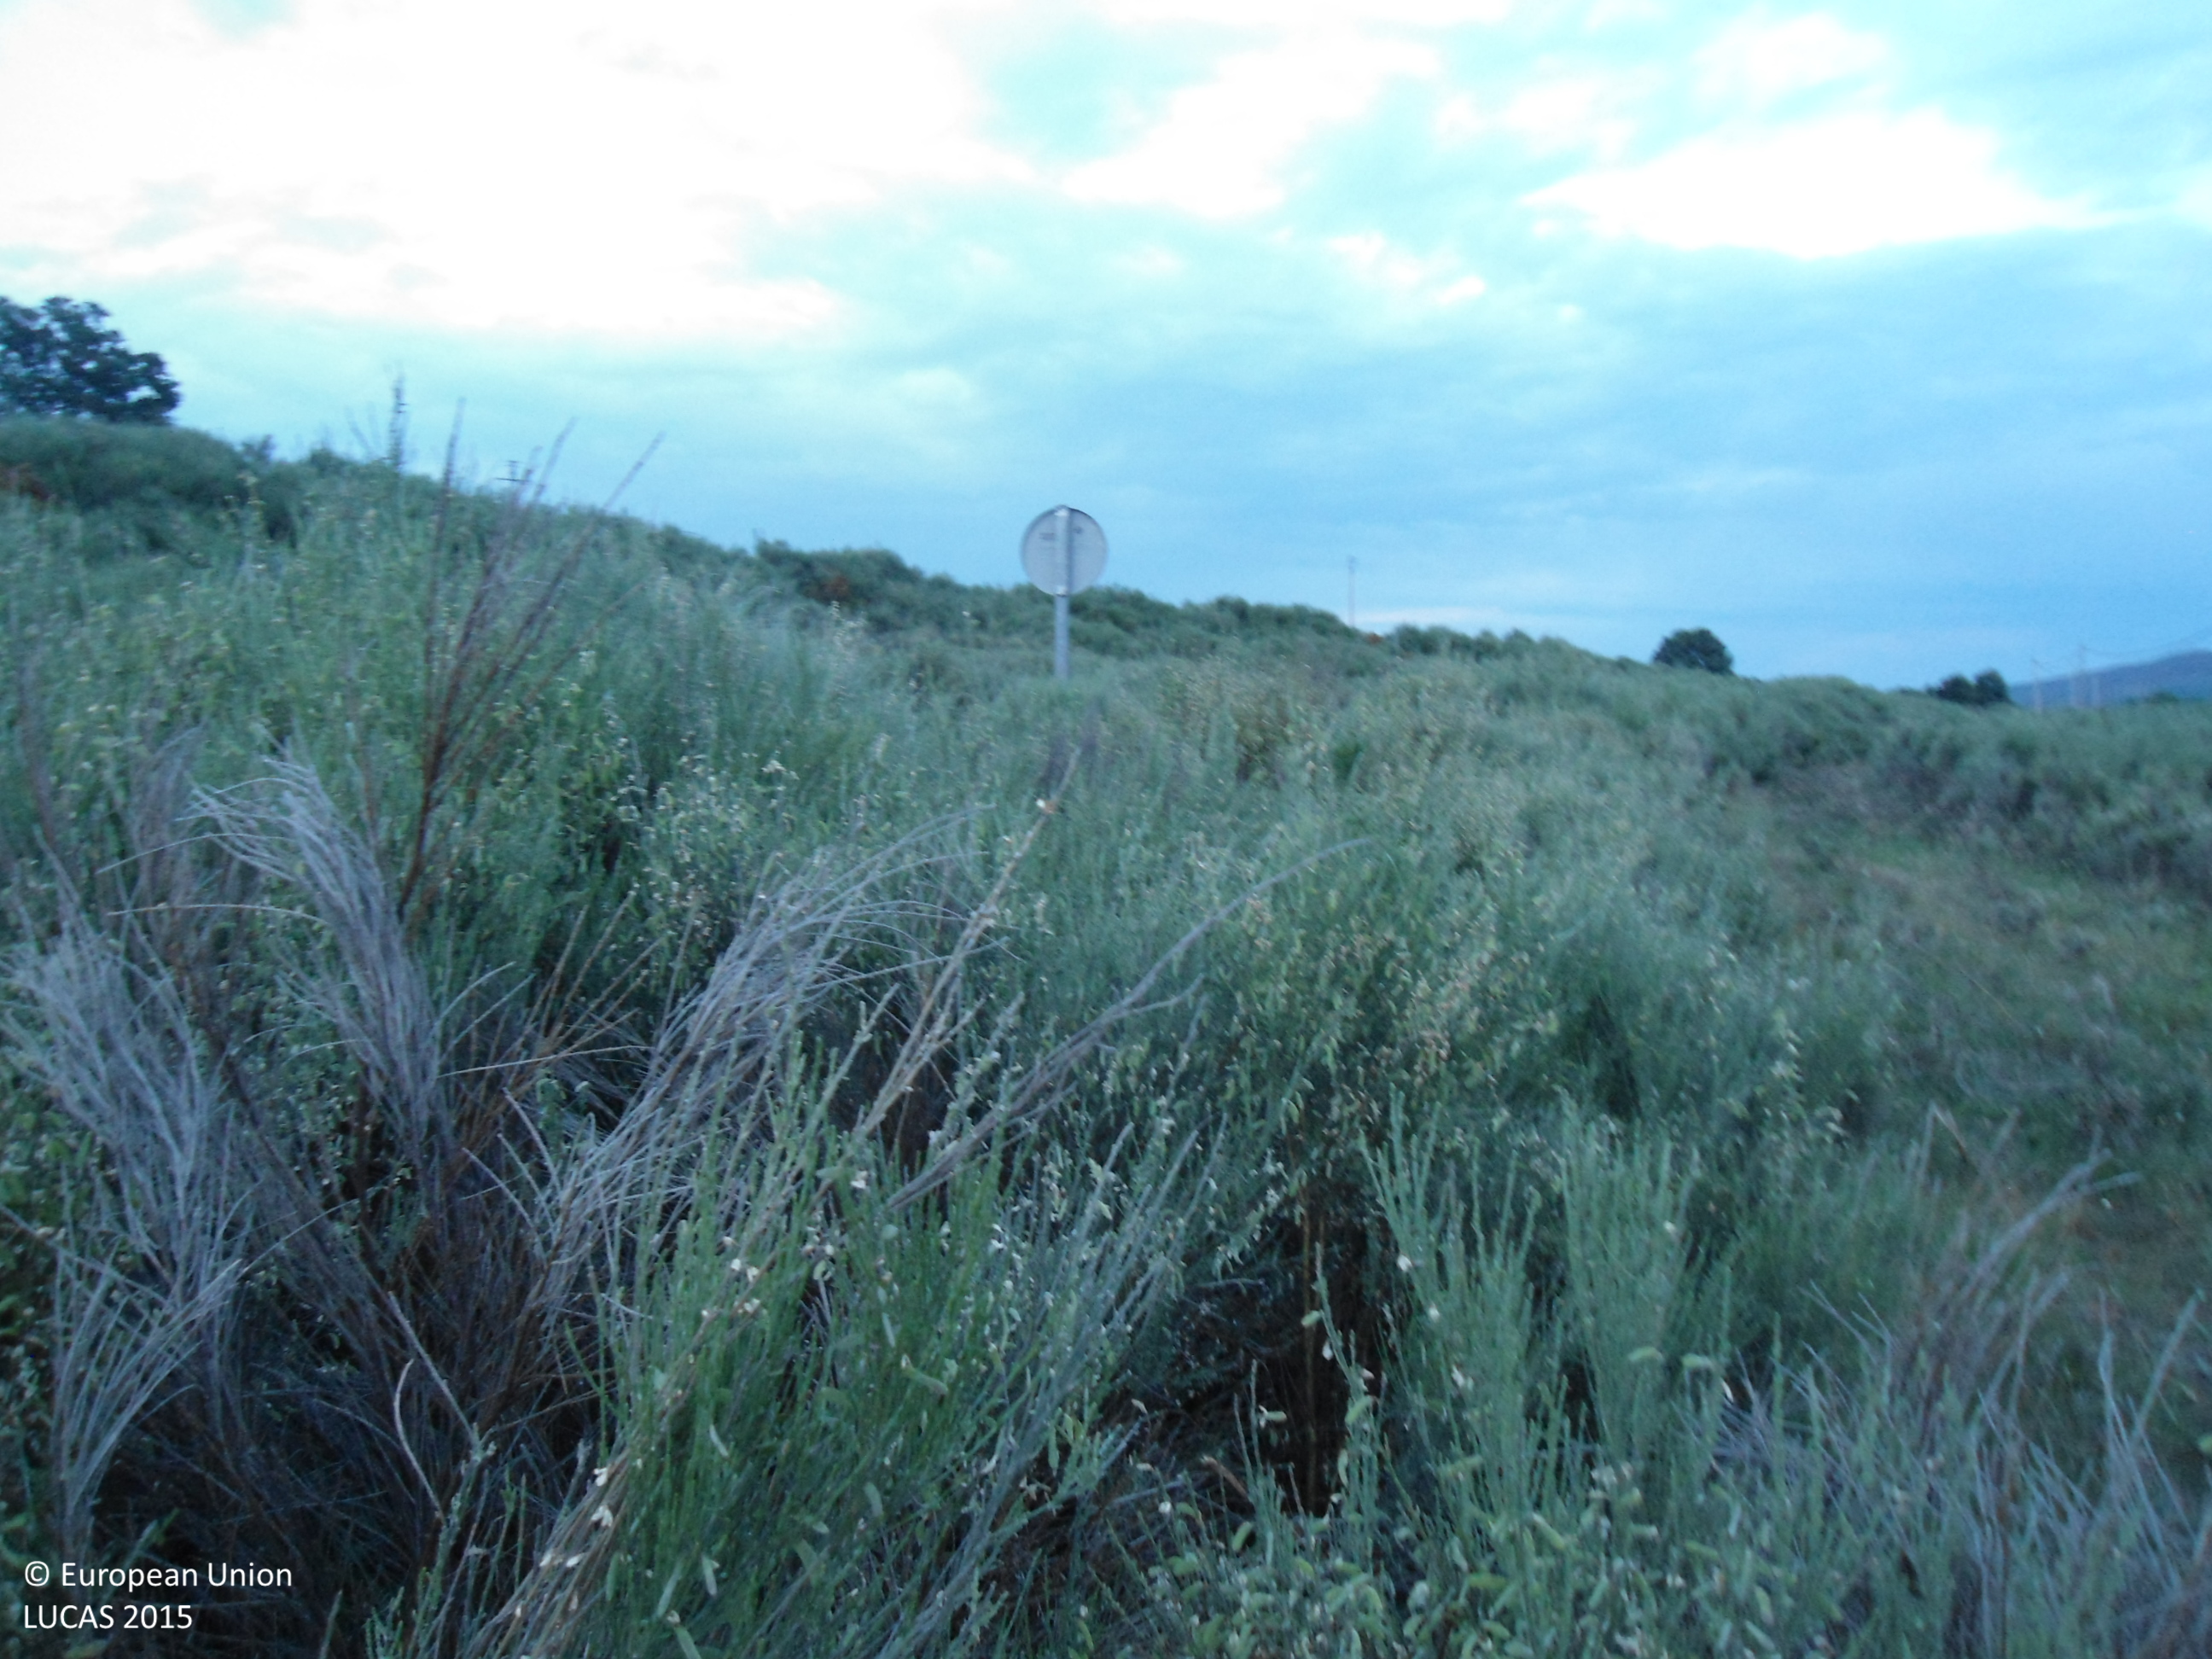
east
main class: Shrubland
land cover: Shrubland without tree cover
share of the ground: > 75 %
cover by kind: shrubs 100 %
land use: Semi-natural and natural areas not in use
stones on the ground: < 10 %
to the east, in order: Shrubland without tree cover; Paved roads, cycling and walking lanes; Shrubland without tree cover; Electric lines; Shrubland without tree cover; Electric lines; Shrubland without tree cover
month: June
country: ES
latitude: 42.1505
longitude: -6.6334
